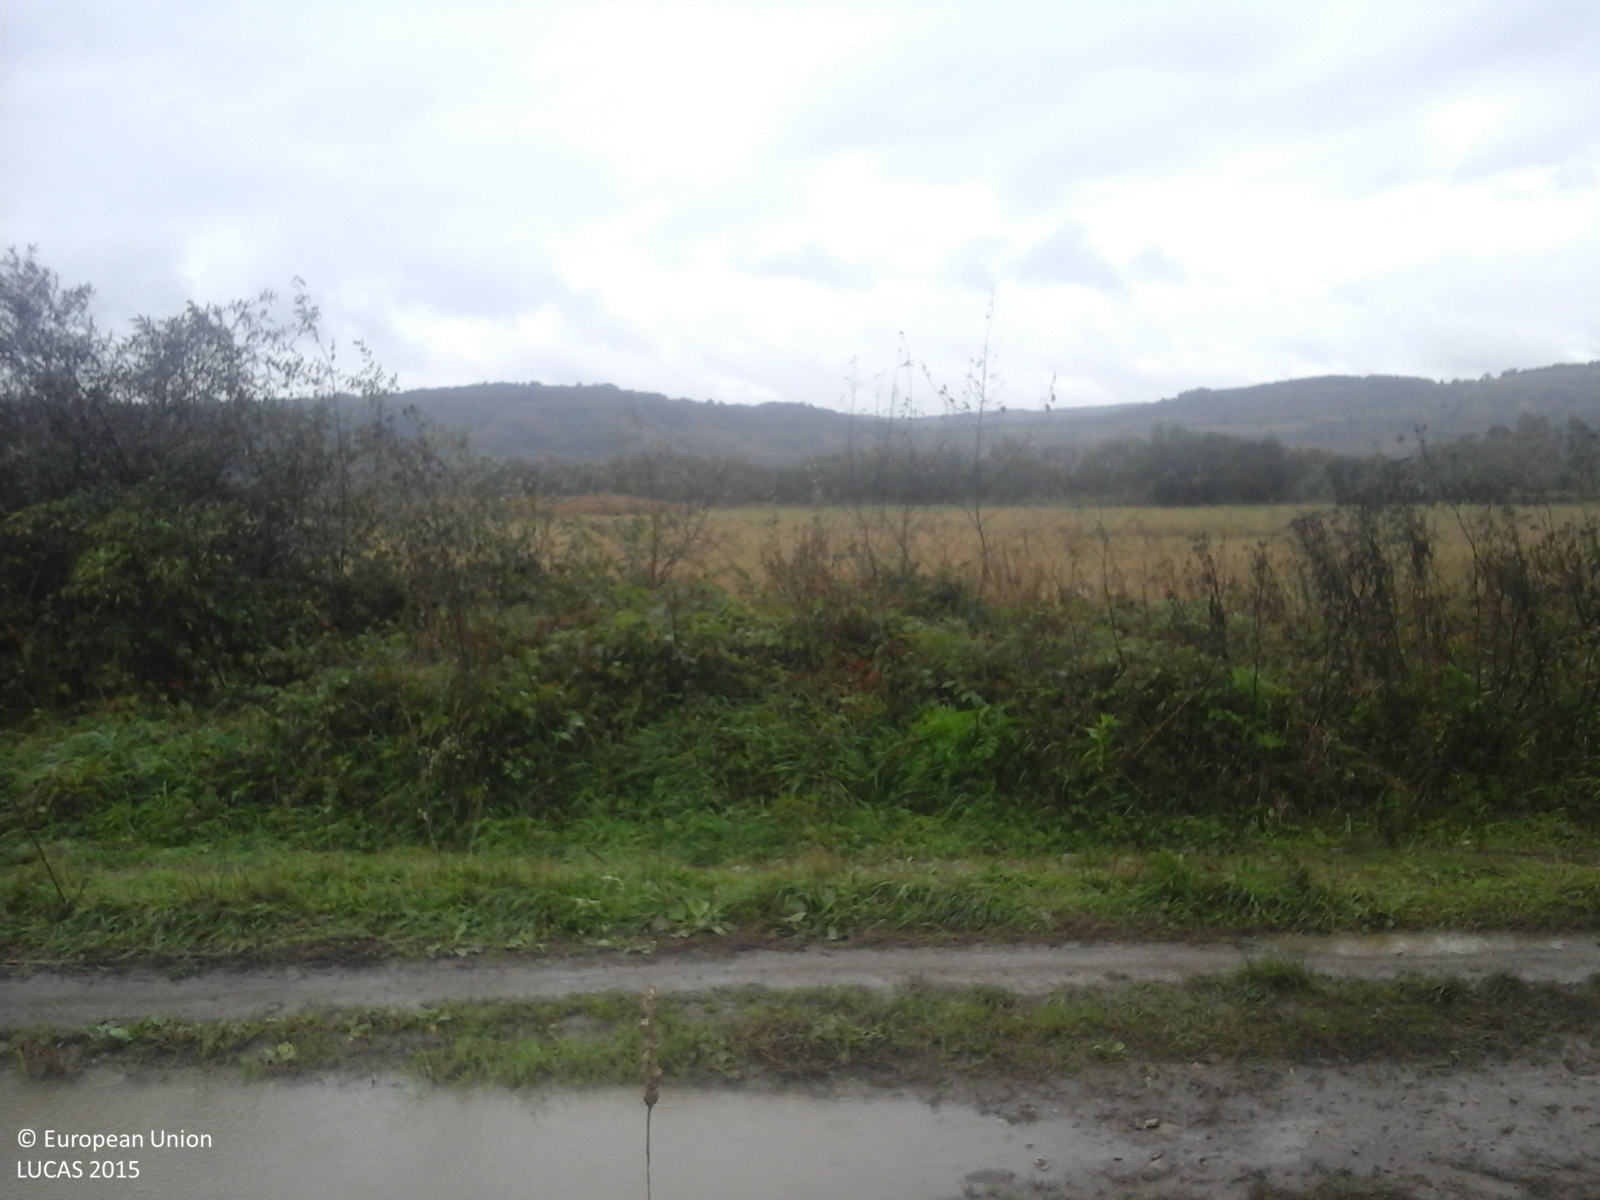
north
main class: Grassland
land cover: Spontaneously vegetated surfaces
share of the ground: > 75 %
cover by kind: herbaceous plants 100 %
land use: Fallow land
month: October
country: RO
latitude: 45.7917
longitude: 24.6601
